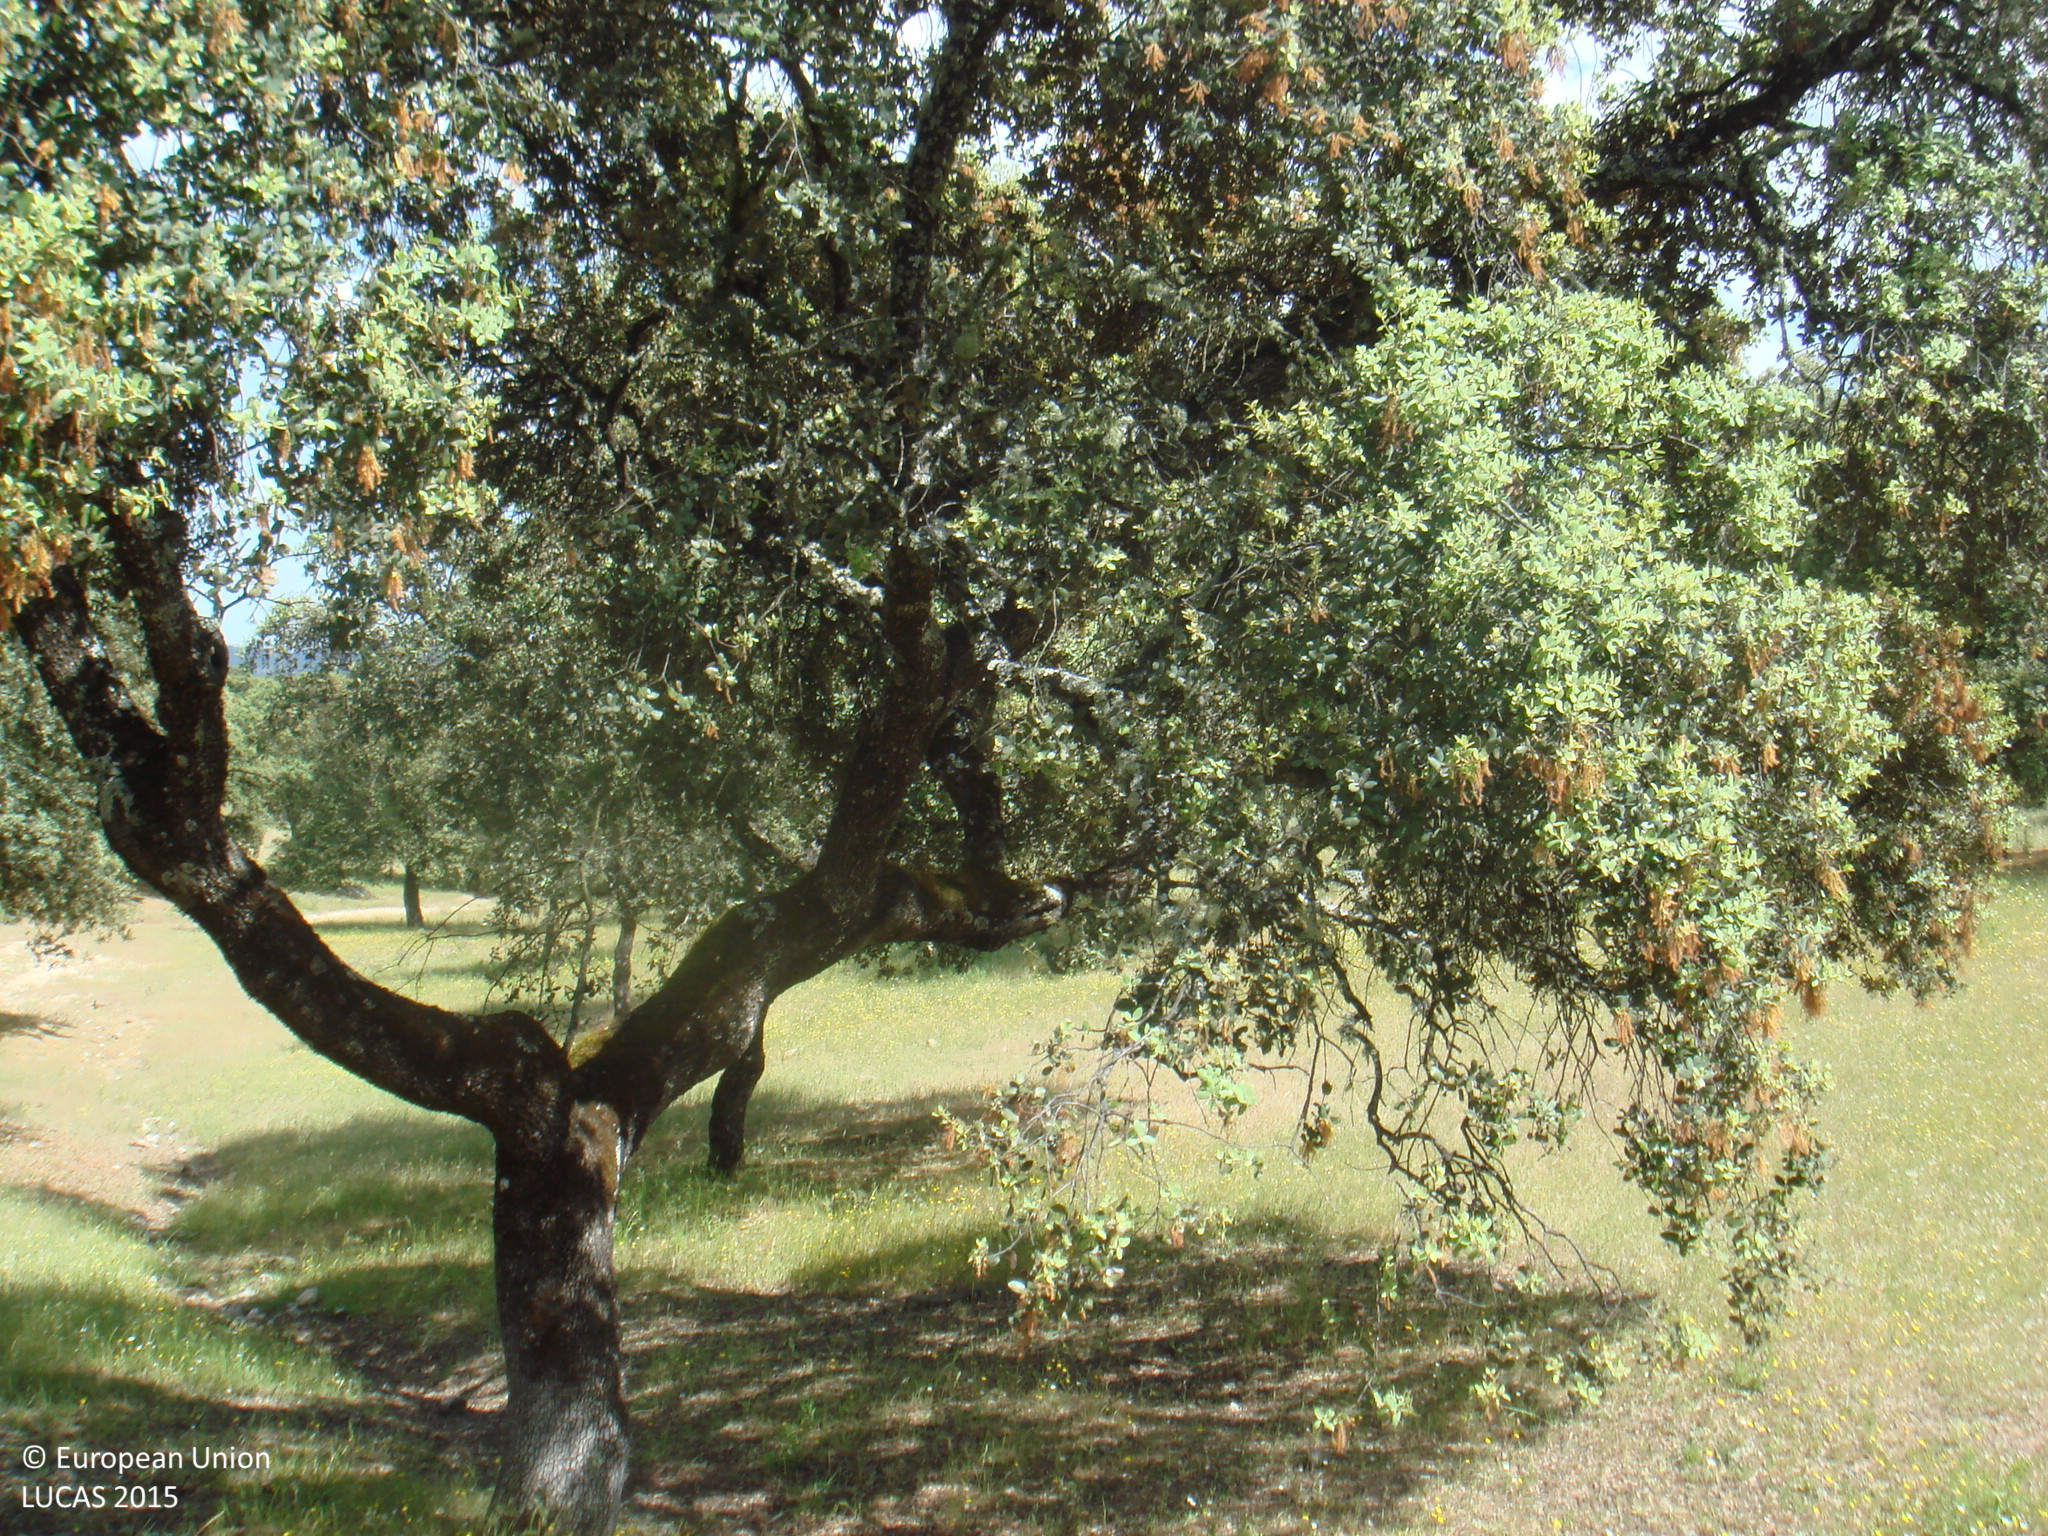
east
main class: Woodland
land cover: Broadleaved woodland
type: broadleaved evergreen forest
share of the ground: 25 - 50 %
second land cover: Spontaneously vegetated surfaces
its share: > 75 %
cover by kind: herbaceous plants 60 %, broadleaved forest trees 40 %
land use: Forestry
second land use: Agriculture (excluding fallow land and kitchen gardens)
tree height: > 5 m
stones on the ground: < 10 %
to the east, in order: Broadleaved woodland; Spontaneously vegetated surfaces; Fences; Broadleaved woodland; Grassland with sparse tree/shrub cover; Fences; Grassland without tree/shrub cover; Rivers and streams; Broadleaved woodland
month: May
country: ES
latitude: 38.3399
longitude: -4.3749
